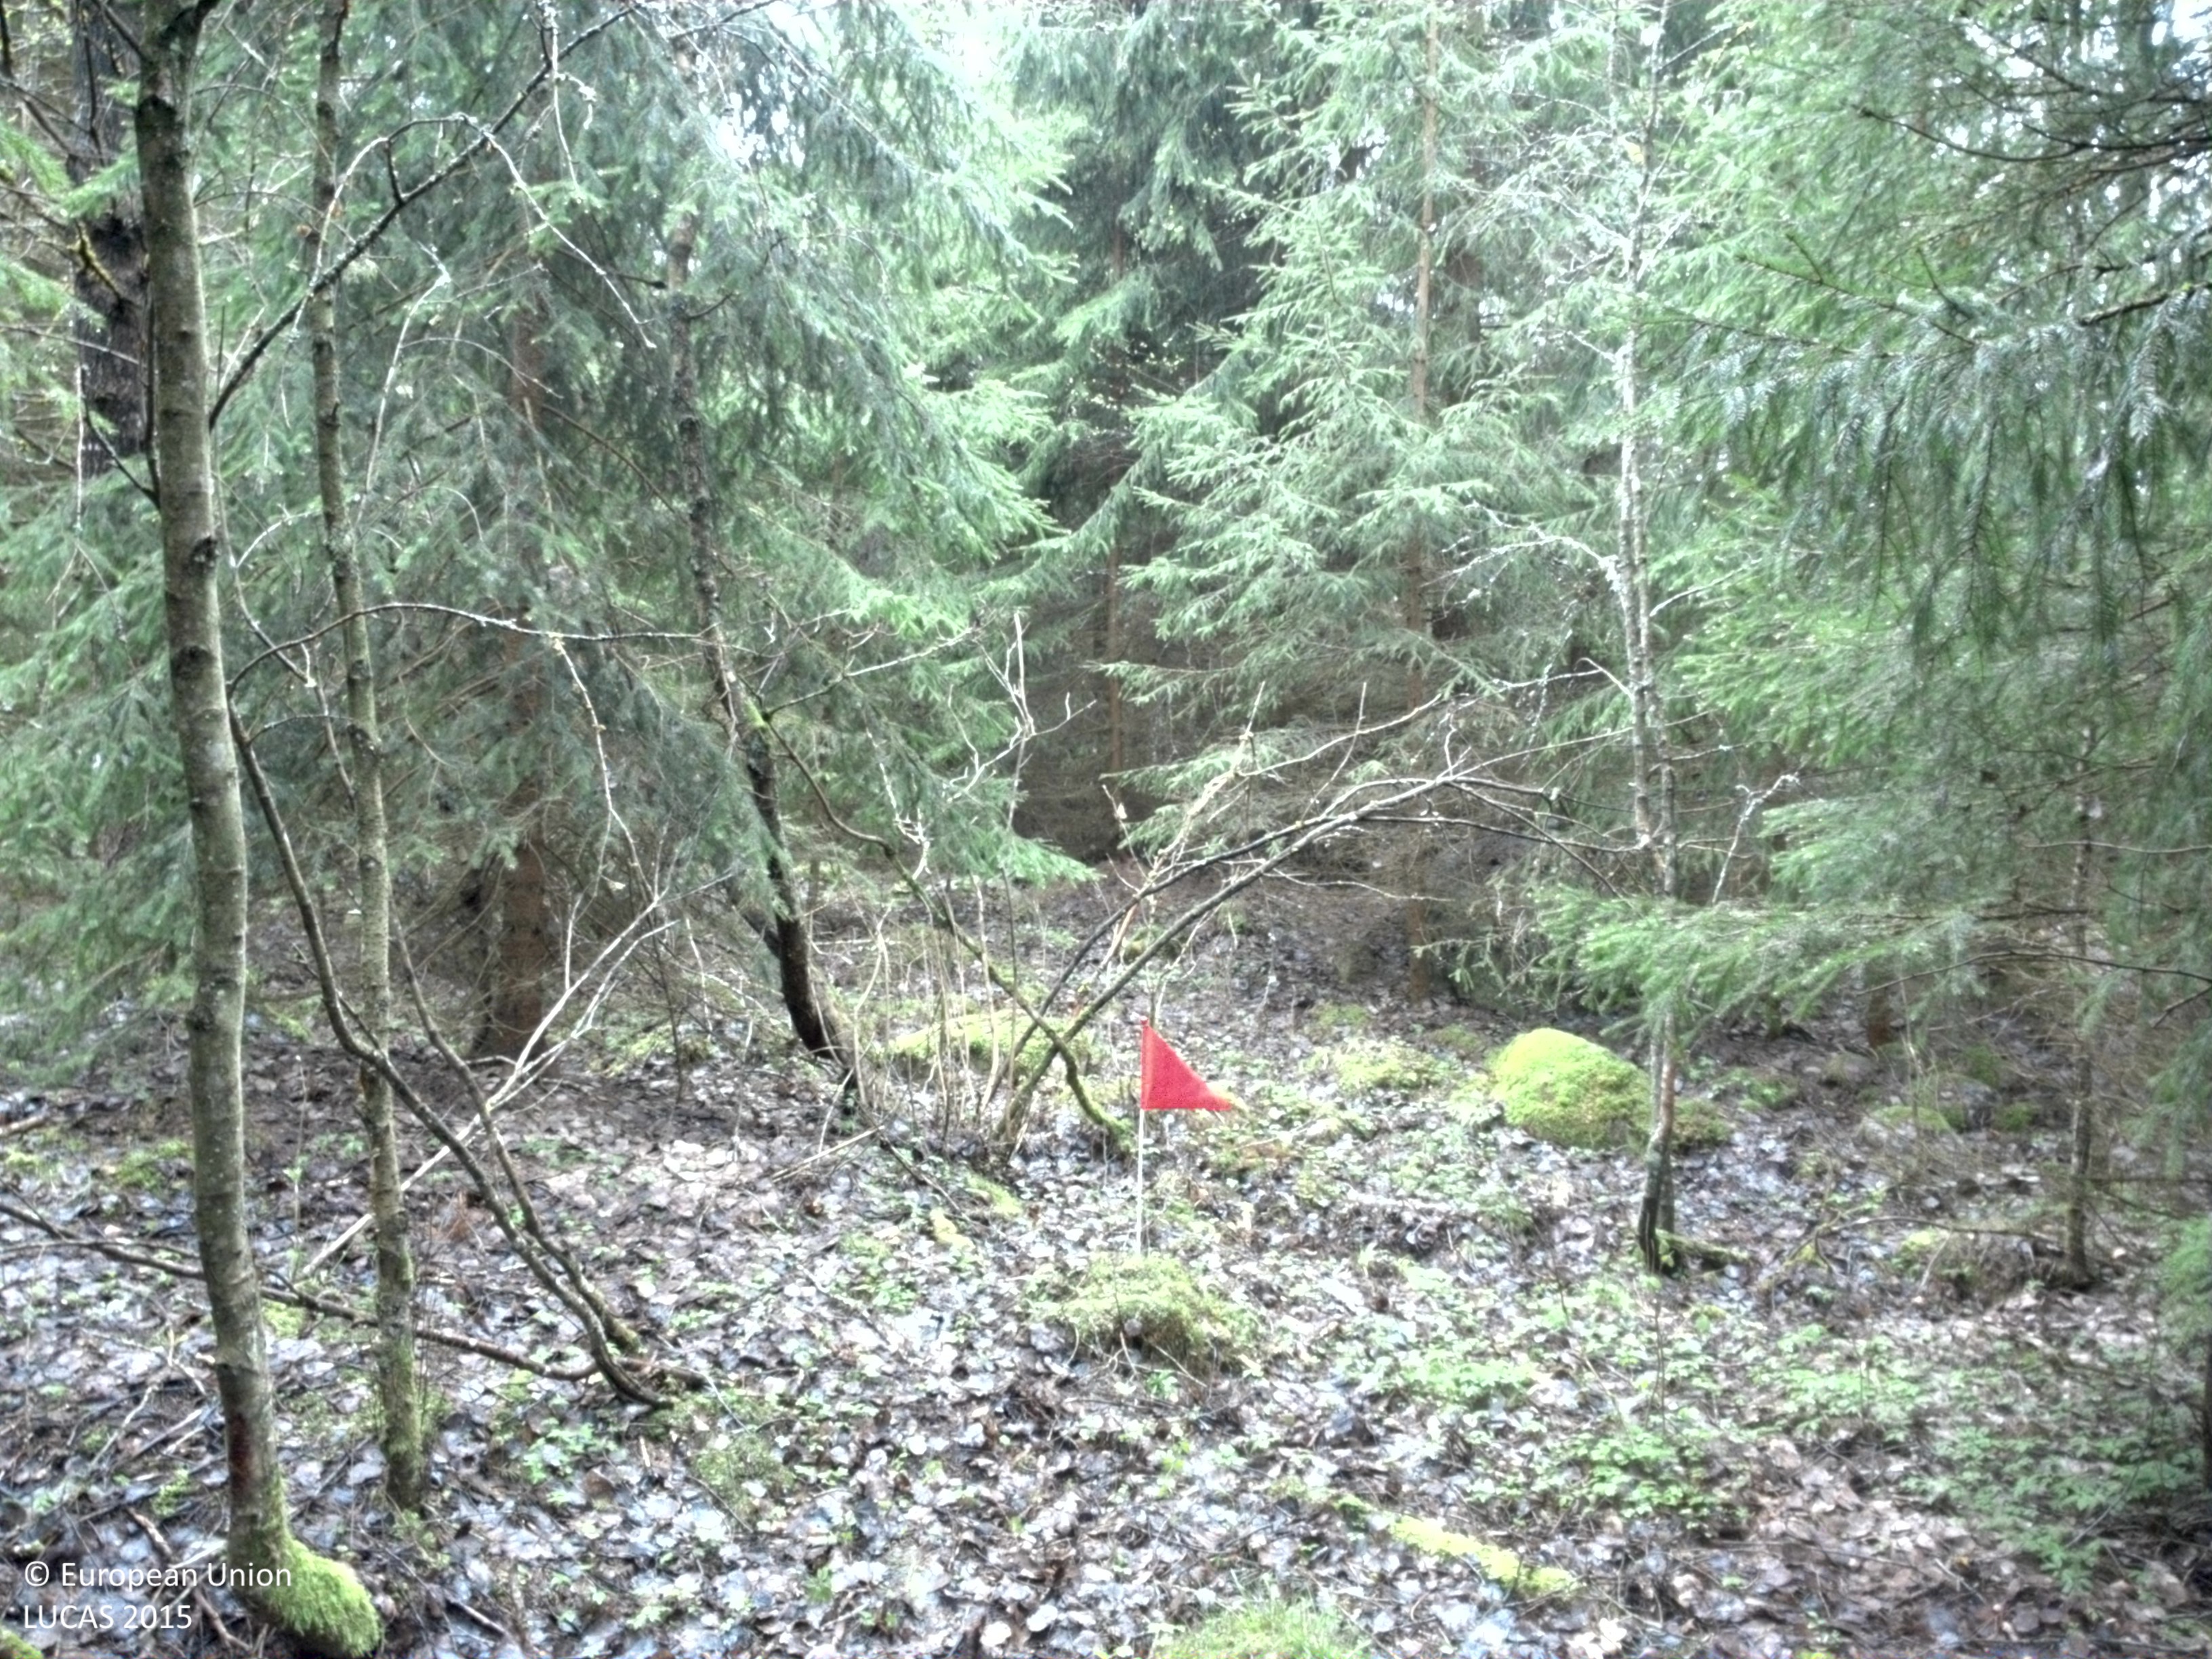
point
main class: Woodland
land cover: Spruce dominated mixed woodland
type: boreal forest
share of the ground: > 75 %
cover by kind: coniferous forest trees 40 %, broadleaved forest trees 40 %, lichens and mosses 20 %
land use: Forestry
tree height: > 5 m
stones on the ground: < 10 %
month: May
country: SE
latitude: 56.6820
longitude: 15.0745
